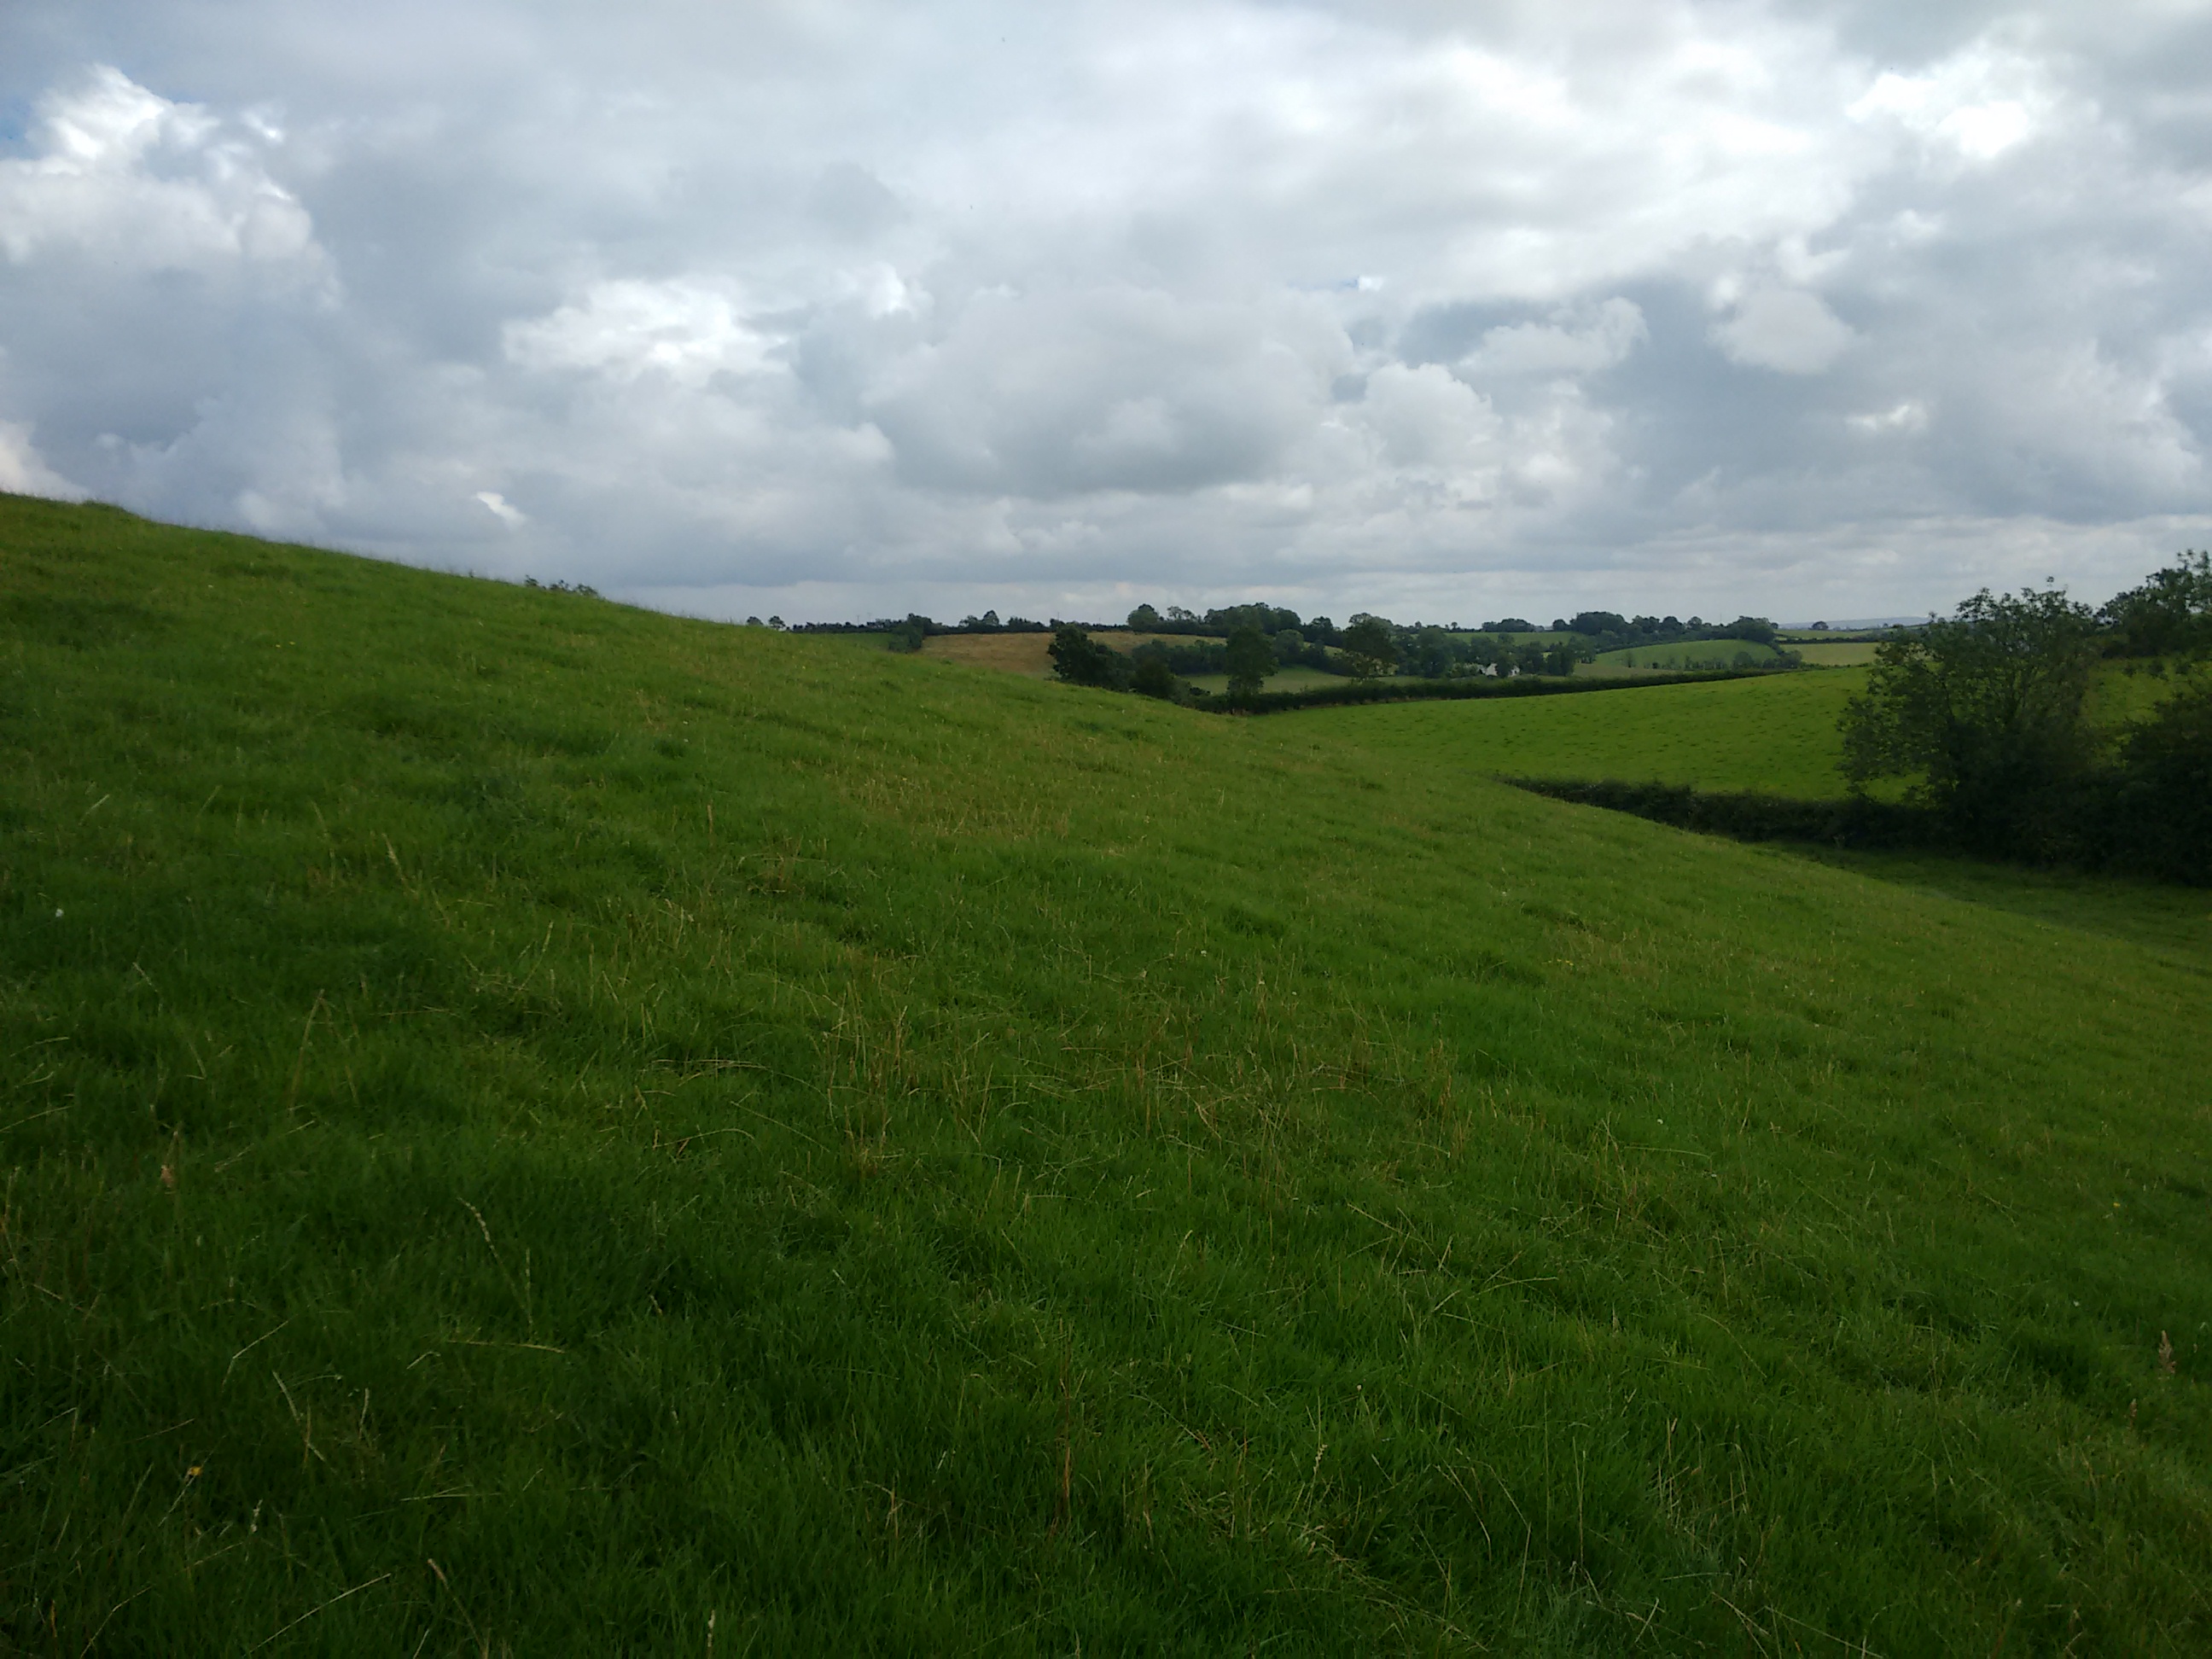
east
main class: Grassland
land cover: Grassland without tree/shrub cover
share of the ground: > 75 %
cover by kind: herbaceous plants 100 %
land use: Agriculture (excluding fallow land and kitchen gardens)
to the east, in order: Grassland without tree/shrub cover; Fences; Abandoned hedges; Grassland without tree/shrub cover; Fences; Abandoned hedges; Grassland without tree/shrub cover
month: August
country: GB
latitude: 54.3769
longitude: -6.8704
